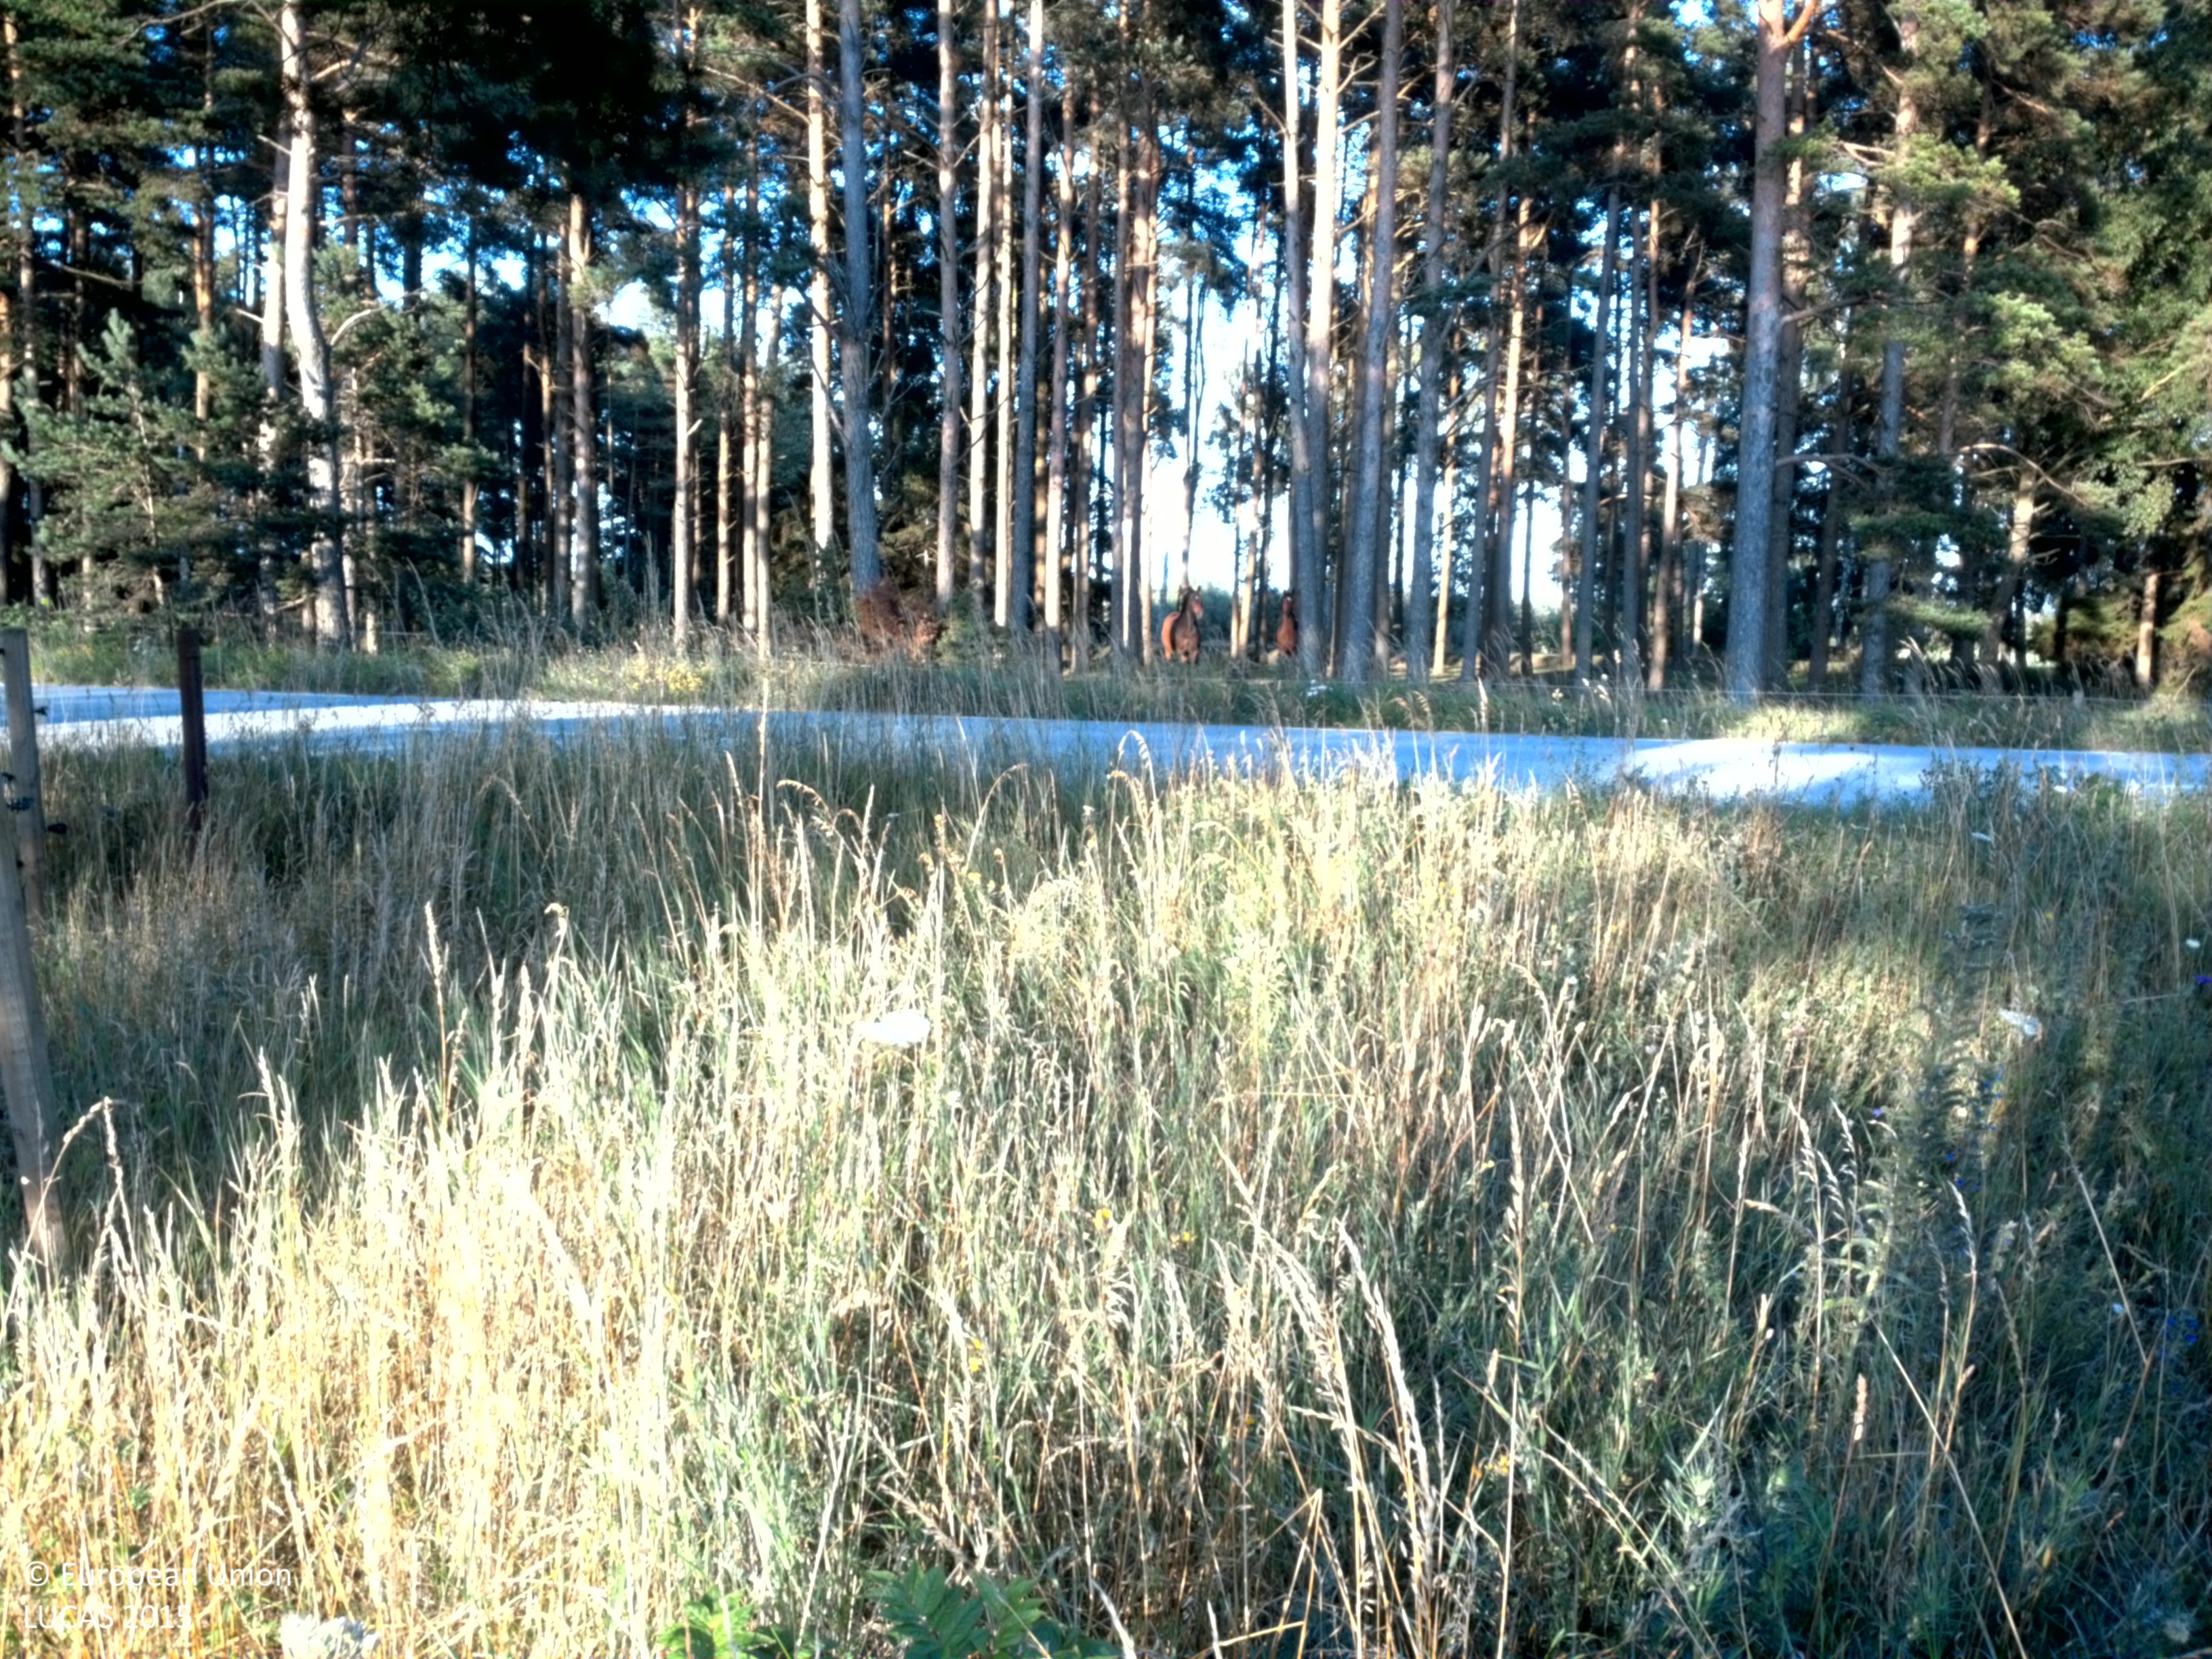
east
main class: Grassland
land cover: Grassland with sparse tree/shrub cover
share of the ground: > 75 %
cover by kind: herbaceous plants 90 %, coniferous forest trees 5 %, unconsolidated bare surface 5 %
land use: Agriculture (excluding fallow land and kitchen gardens)
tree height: > 5 m
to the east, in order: Grassland with sparse tree/shrub cover; Fences; Grassland without tree/shrub cover; Paved roads, cycling and walking lanes; Grass margins; Fences; Pine dominated coniferous woodland; Fences; Spontaneously vegetated surfaces; Abandoned hedges; Ditches and canals; Fences; Other leguminous and mixtures for fodder
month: July
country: SE
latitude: 57.2446
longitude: 18.2107
